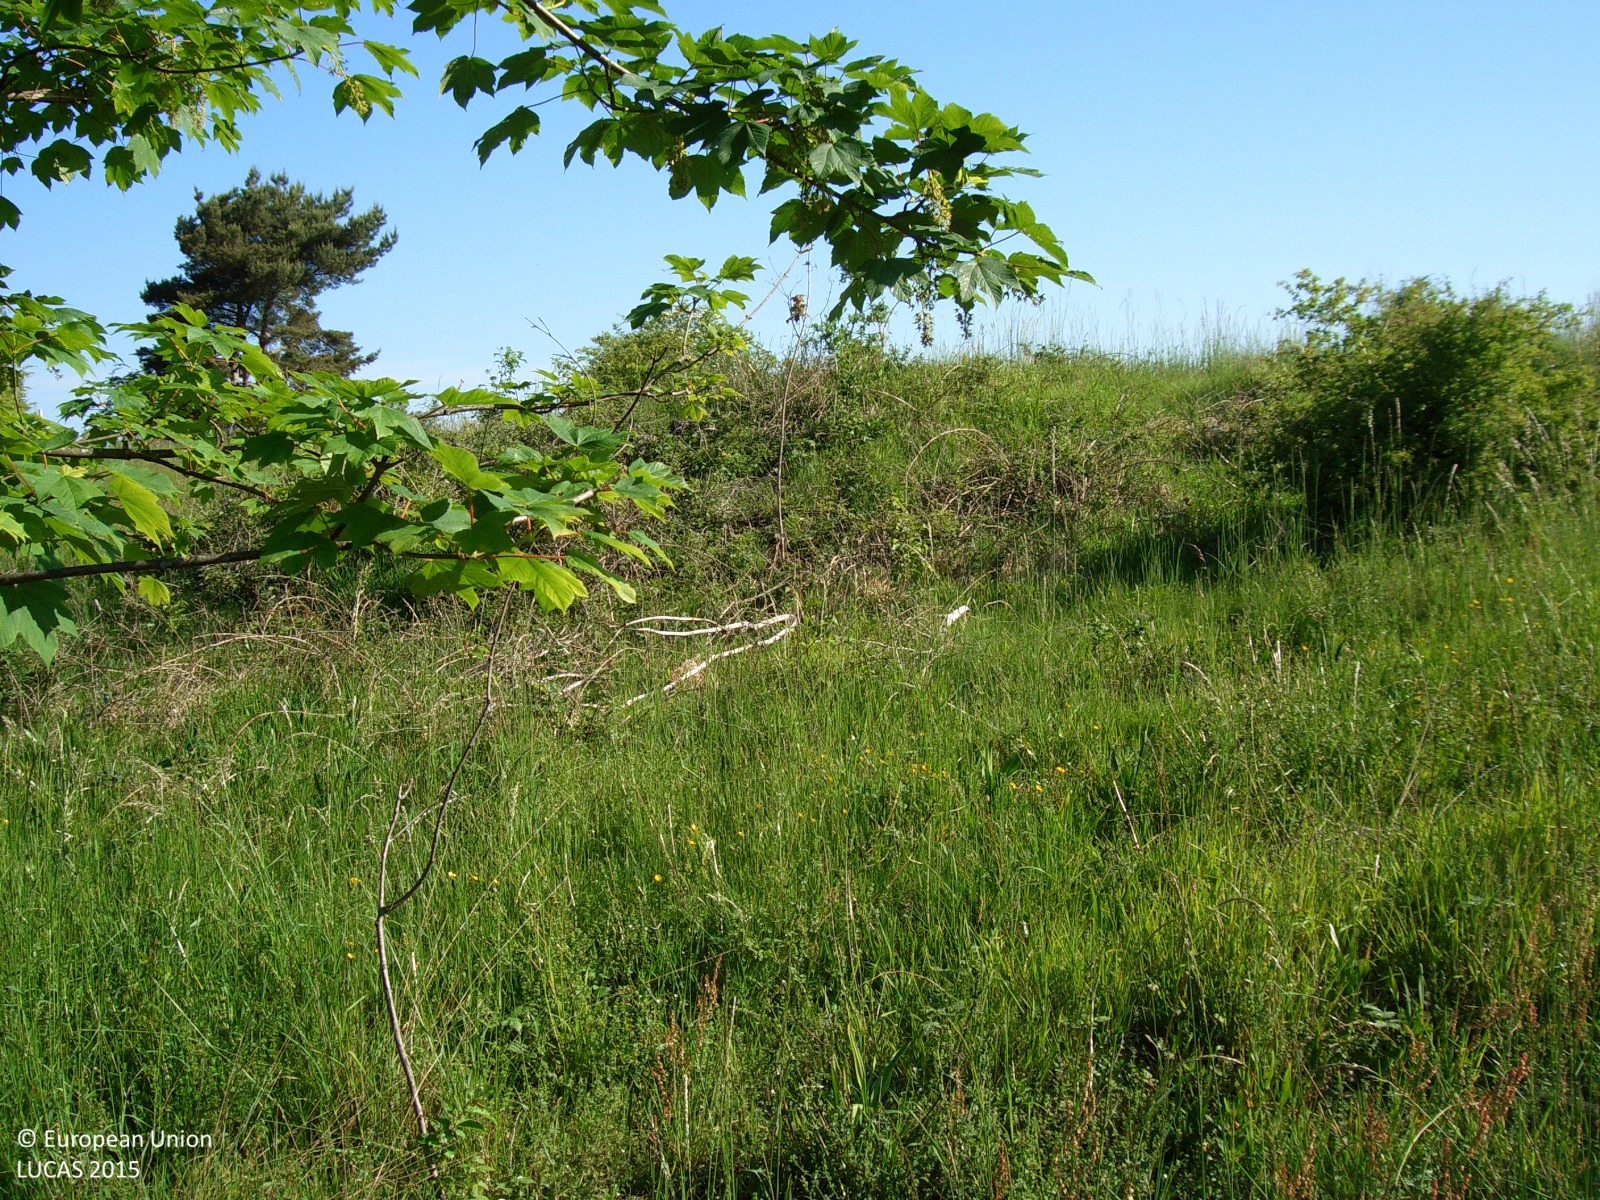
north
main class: Woodland
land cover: Broadleaved woodland
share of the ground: 10 - 25 %
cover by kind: herbaceous plants 80 %, broadleaved forest trees 20 %
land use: Forestry
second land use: Amenities, museums, leisure
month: June
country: DE
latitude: 50.7344
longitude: 6.2446
